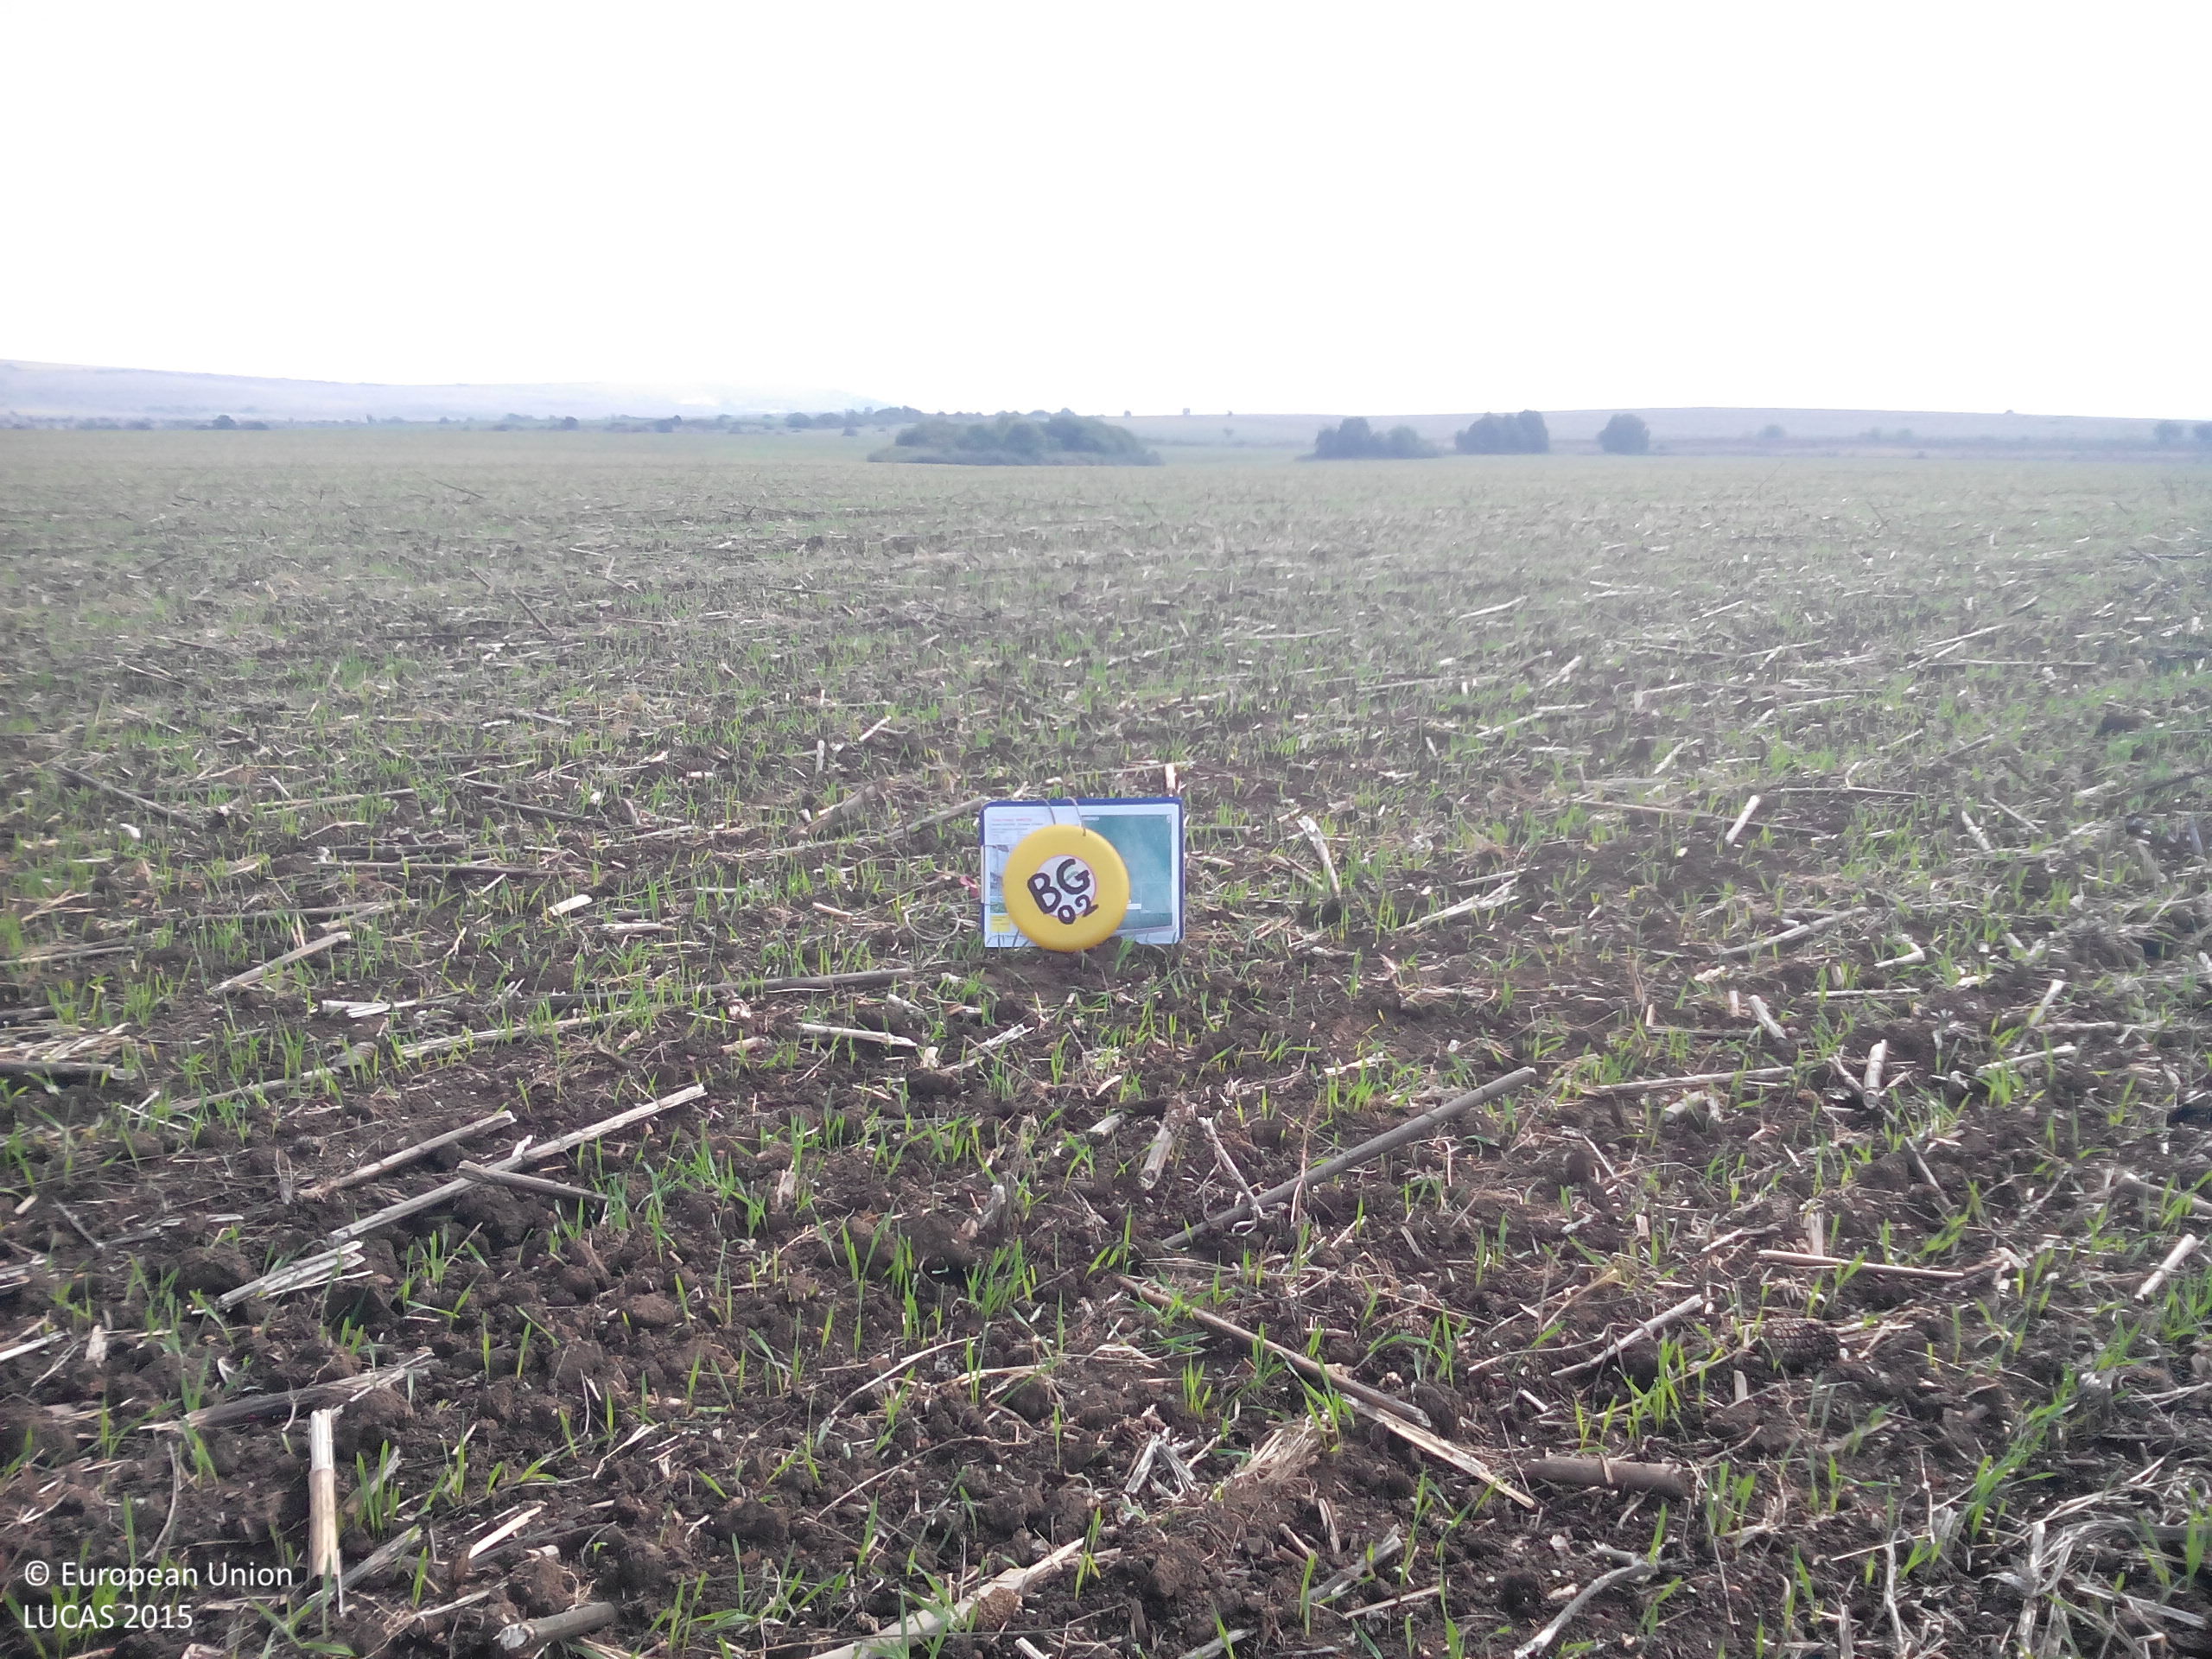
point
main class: Cropland
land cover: Common wheat
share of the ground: 10 - 25 %
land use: Agriculture (excluding fallow land and kitchen gardens)
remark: Harvested field
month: October
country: BG
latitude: 43.2026
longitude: 23.9438
